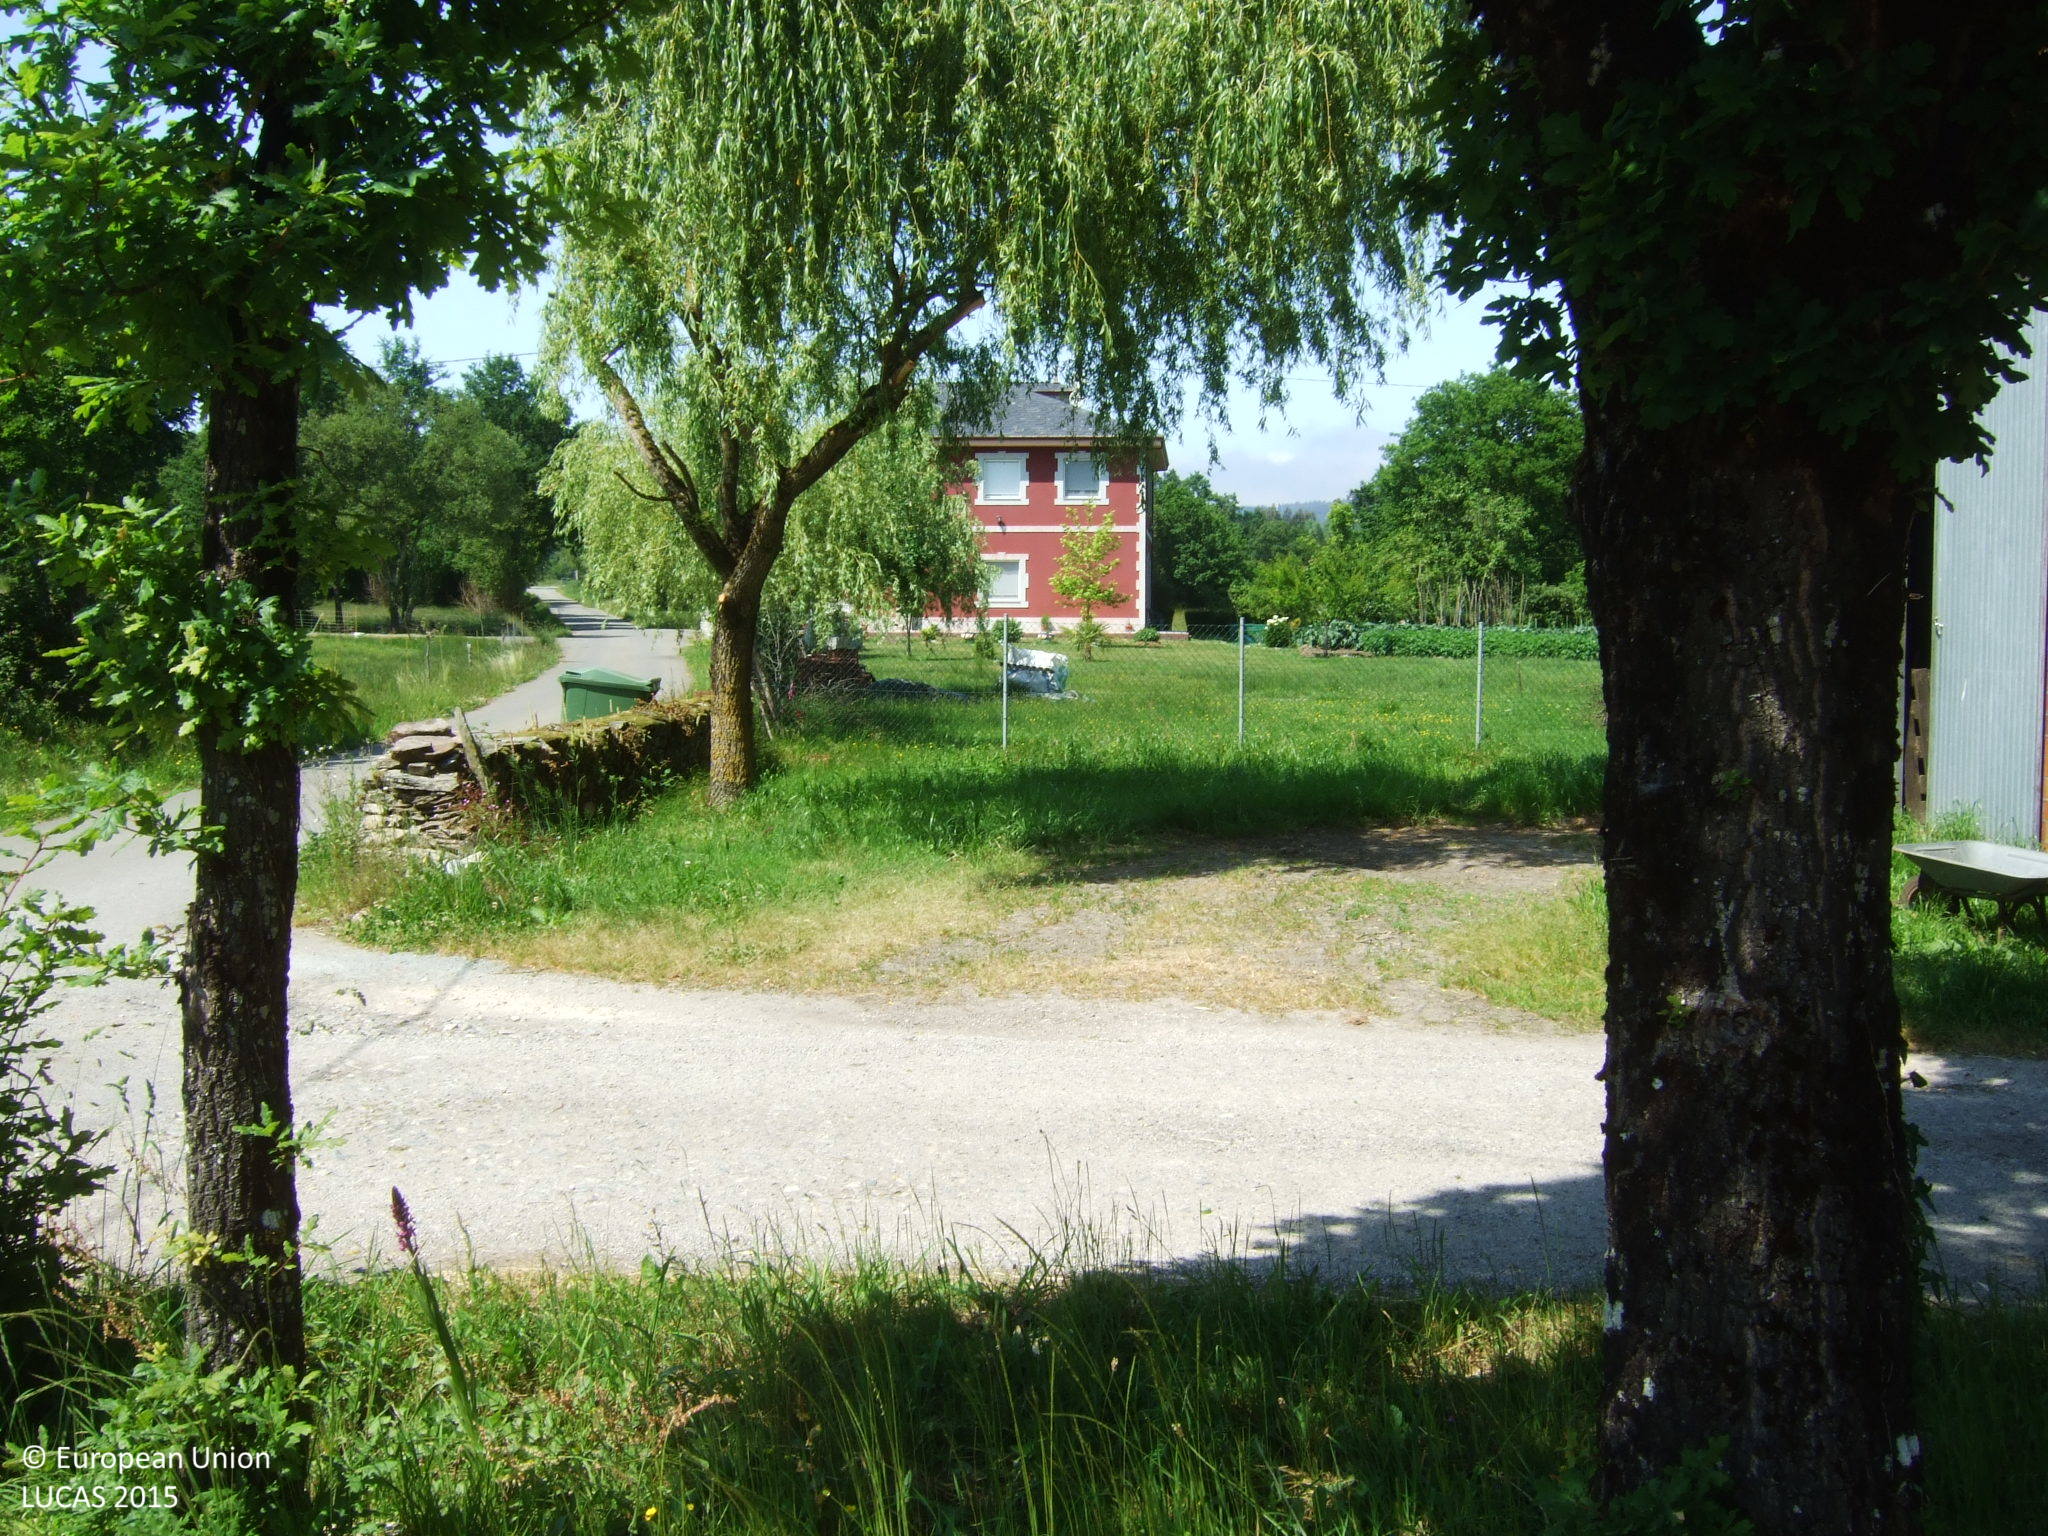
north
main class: Grassland
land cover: Grassland without tree/shrub cover
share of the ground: > 75 %
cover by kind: herbaceous plants 100 %
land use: Agriculture (excluding fallow land and kitchen gardens)
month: June
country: ES
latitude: 43.2790
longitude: -7.4652
